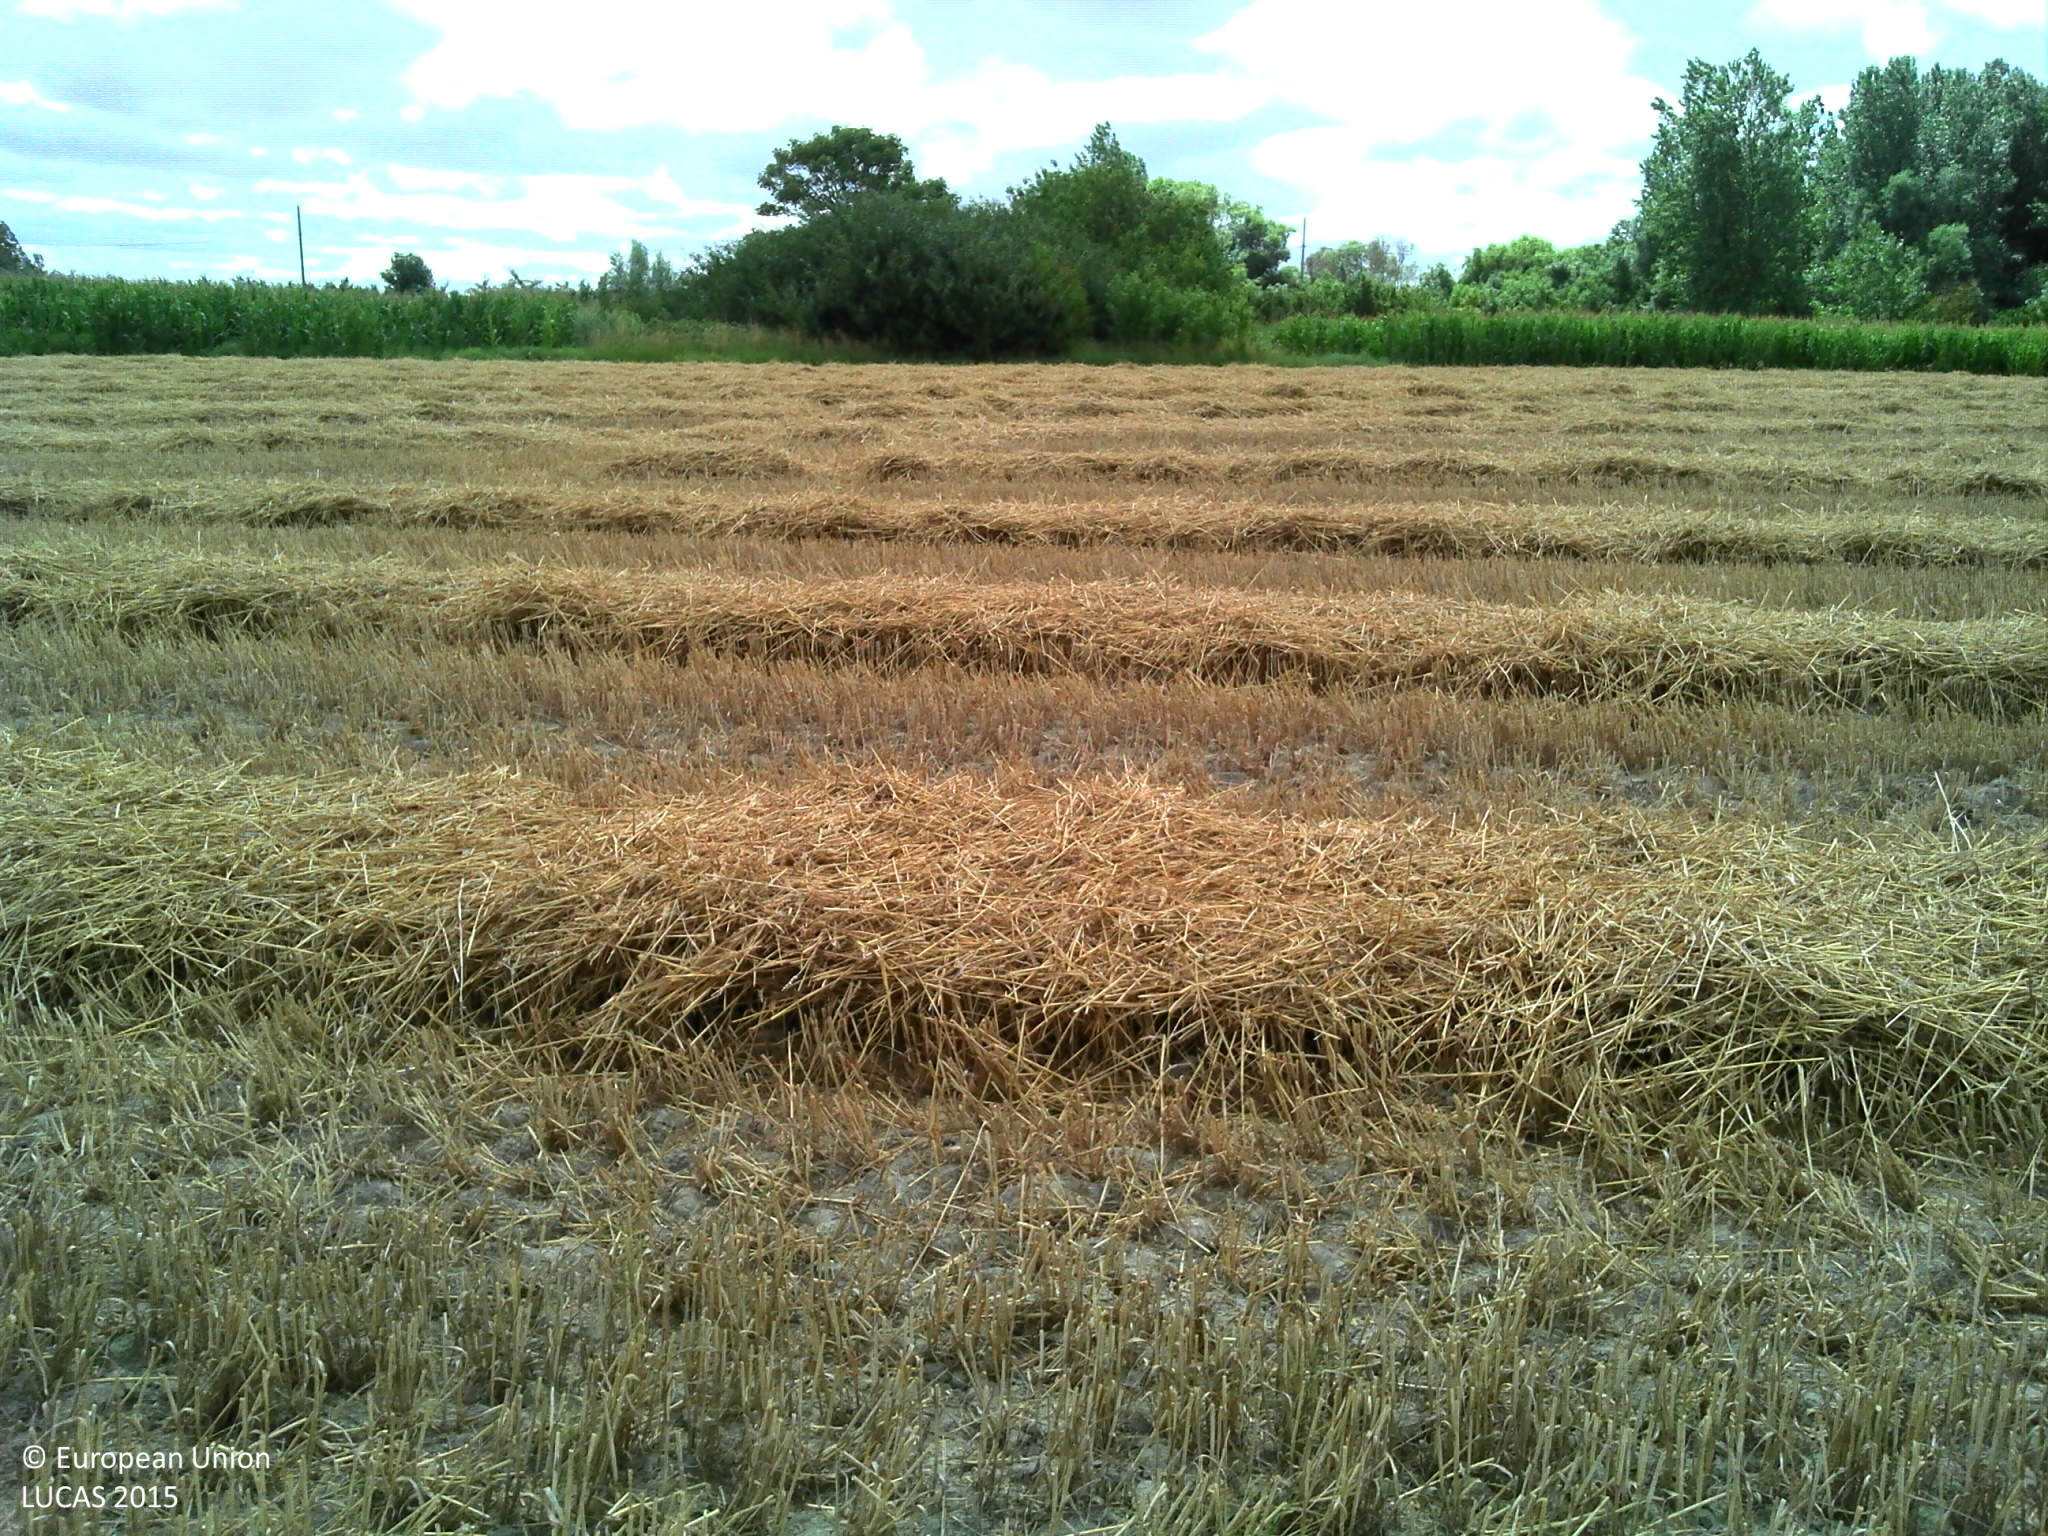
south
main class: Cropland
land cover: Common wheat
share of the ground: 50 - 75 %
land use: Agriculture (excluding fallow land and kitchen gardens)
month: August
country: FR
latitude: 50.9885
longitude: 2.0206
